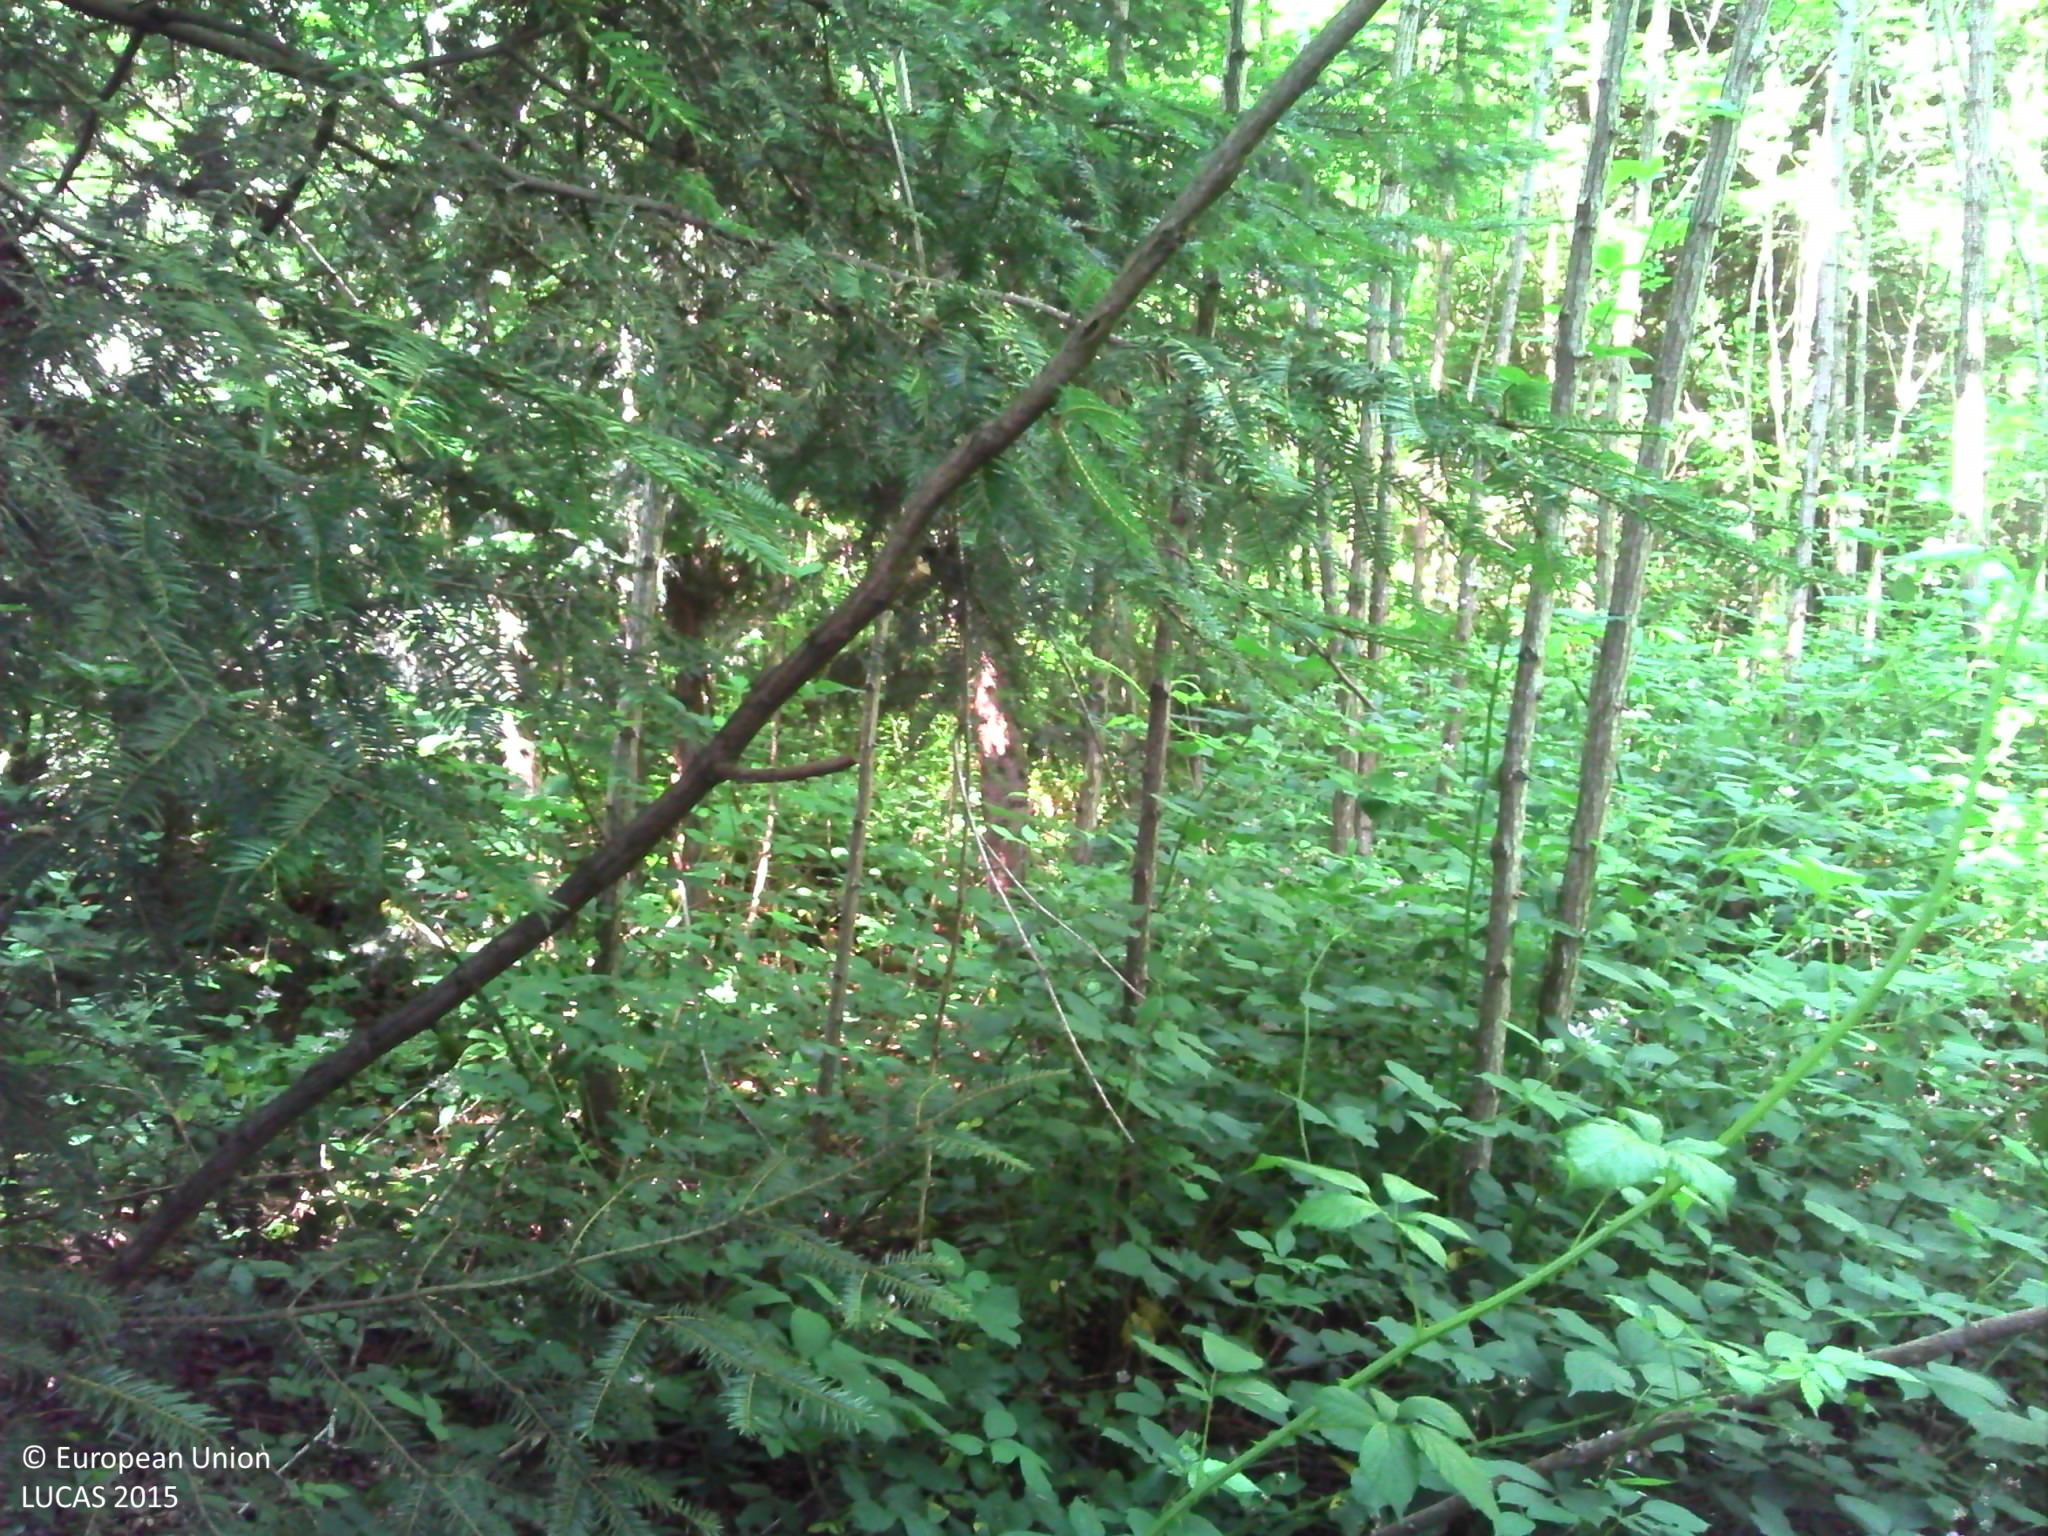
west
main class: Woodland
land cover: Other mixed woodland
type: mesophytic deciduous forest
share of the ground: > 75 %
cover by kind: broadleaved forest trees 75 %, coniferous forest trees 25 %
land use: Semi-natural and natural areas not in use
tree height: > 5 m
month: June
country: FR
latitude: 45.8502
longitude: 0.6502
